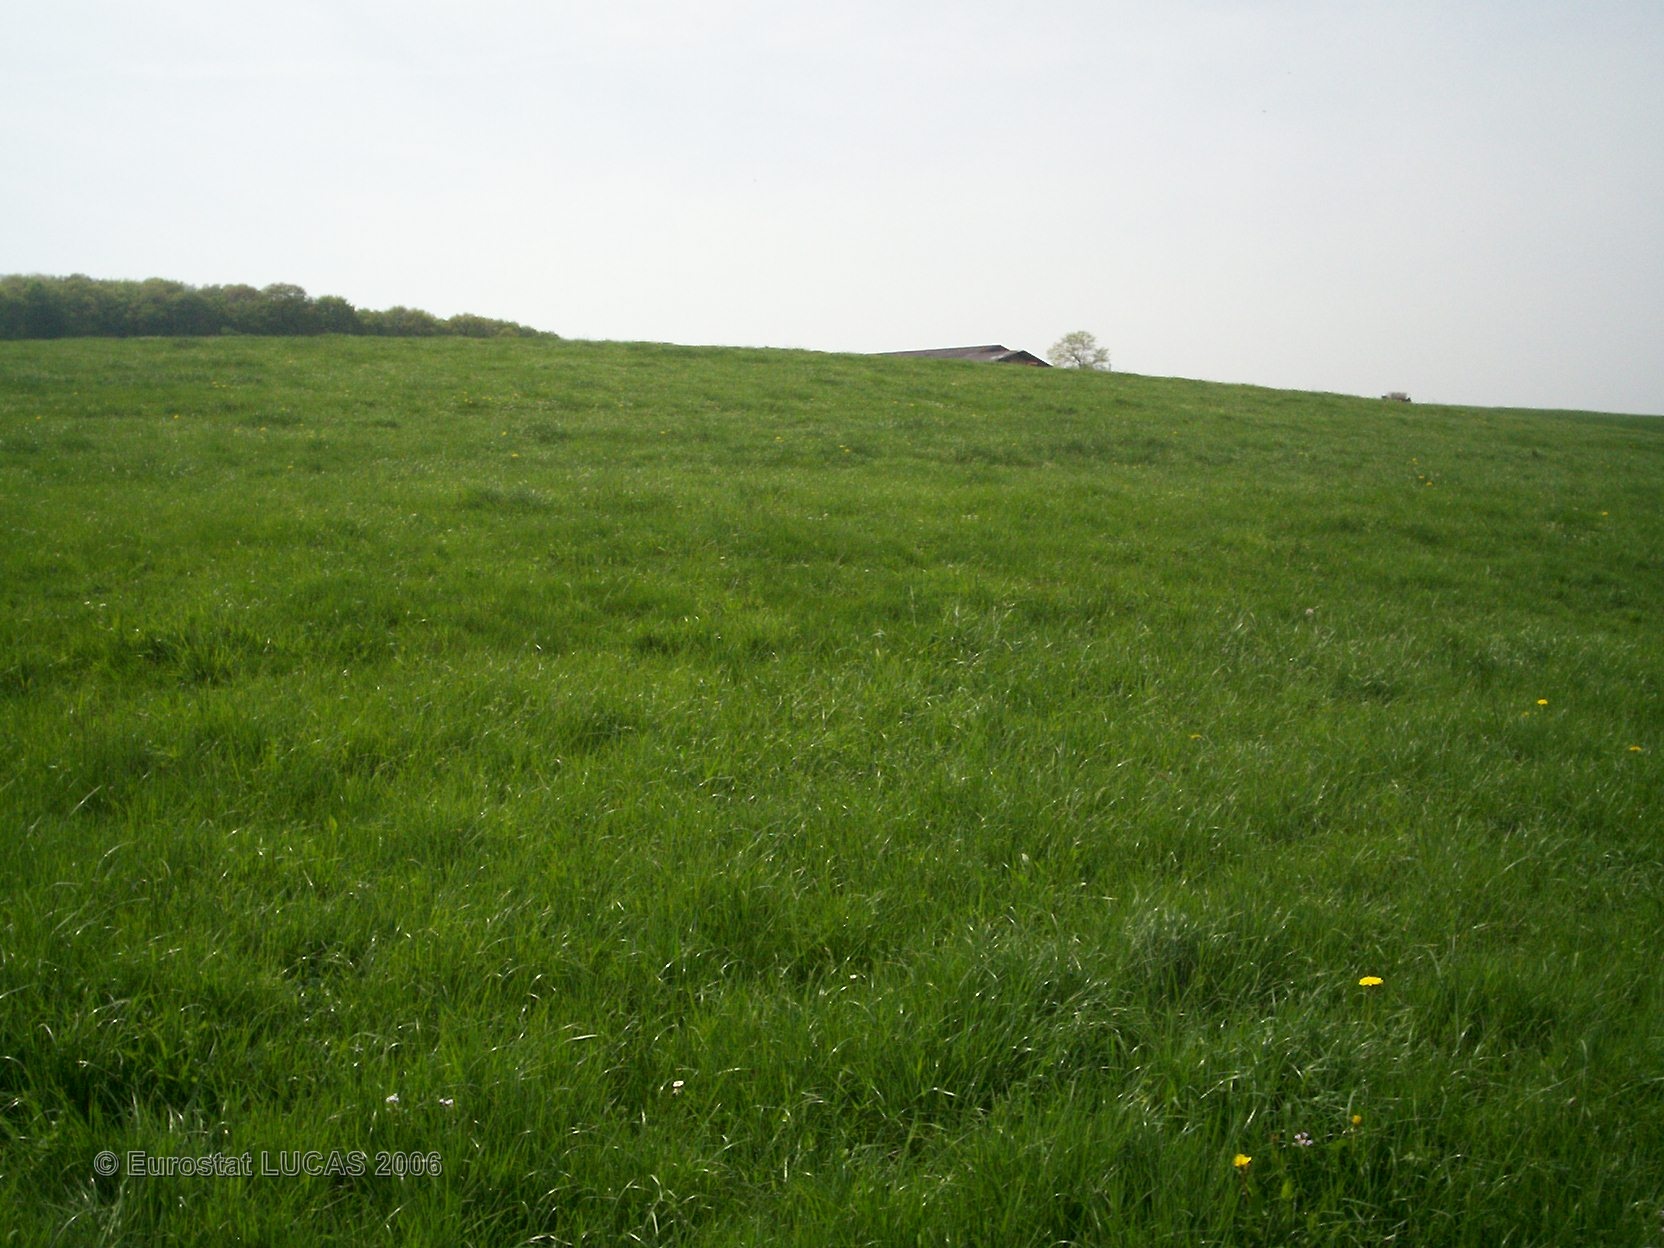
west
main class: Grassland
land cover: Grassland without tree/shrub cover
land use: Agriculture (excluding fallow land and kitchen gardens)
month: May
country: FR
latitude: 49.0650
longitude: 7.0030
